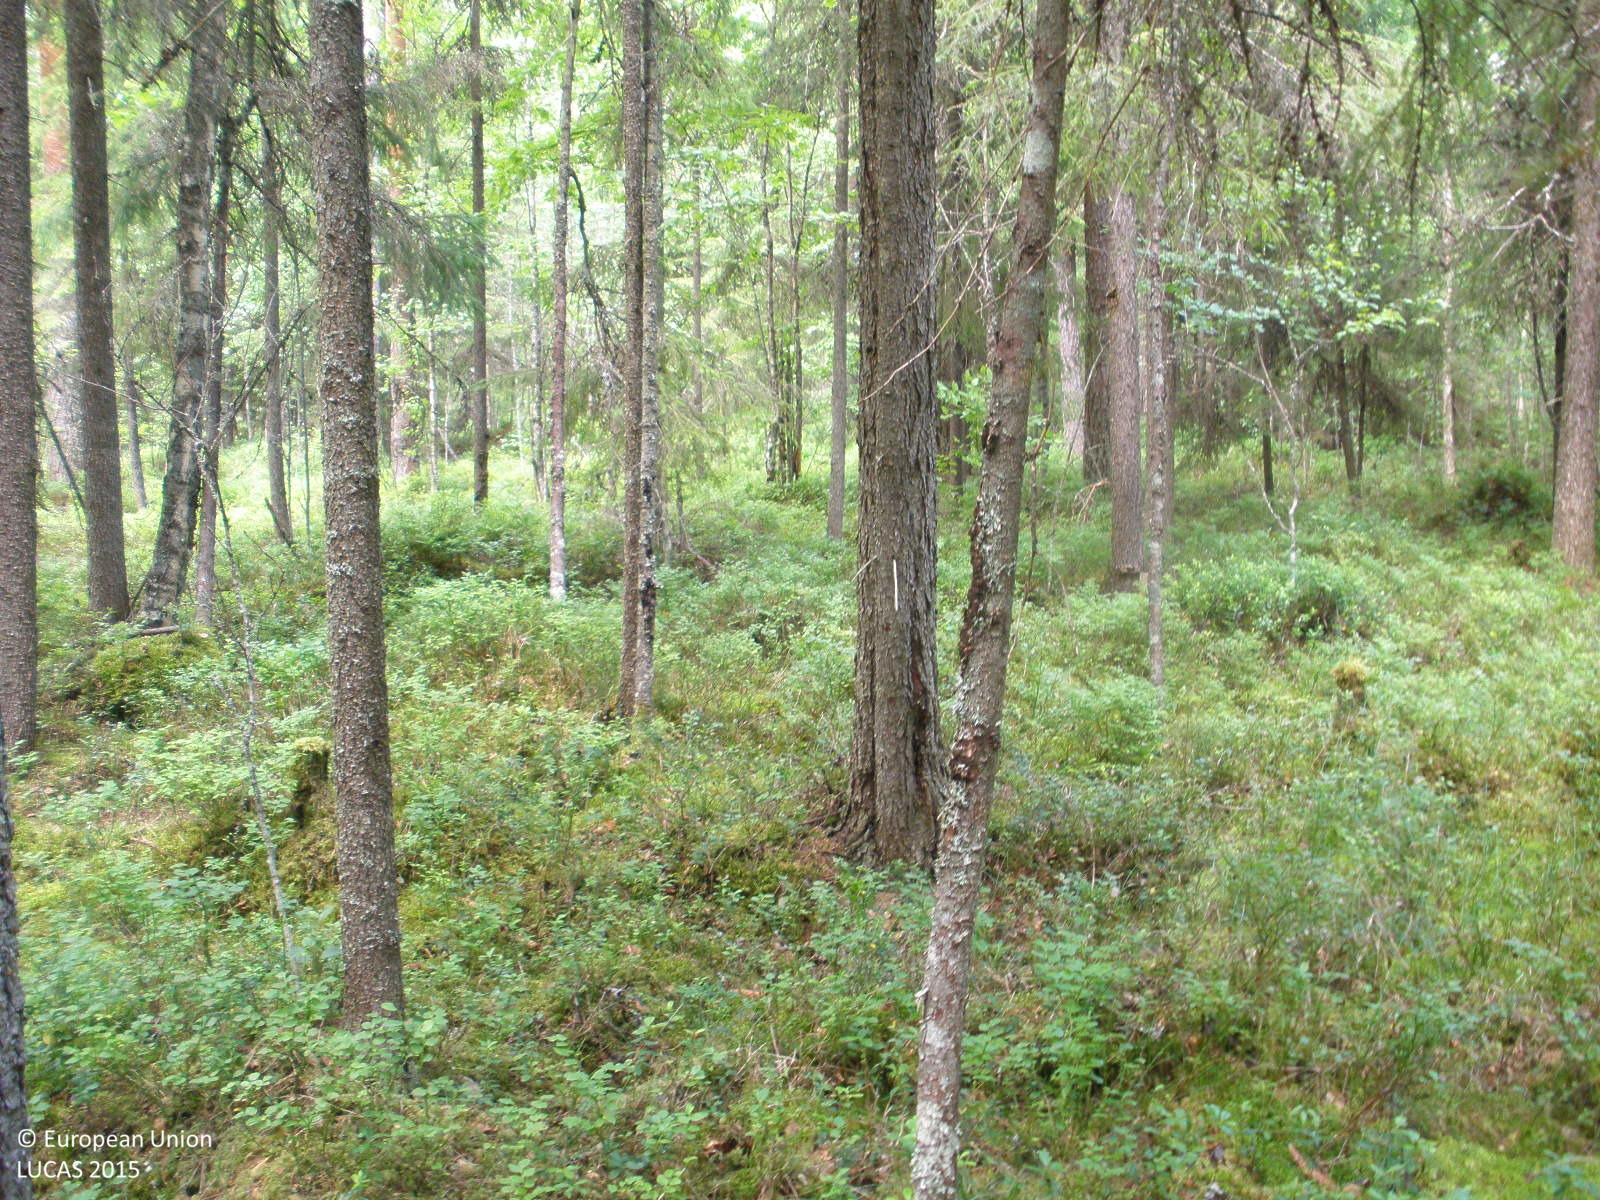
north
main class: Woodland
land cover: Spruce dominated coniferous woodland
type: boreal forest
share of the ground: > 75 %
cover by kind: coniferous forest trees 85 %, broadleaved forest trees 5 %, herbaceous plants 5 %, lichens and mosses 5 %
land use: Forestry
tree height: > 5 m
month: July
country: FI
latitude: 61.4901
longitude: 24.9643
